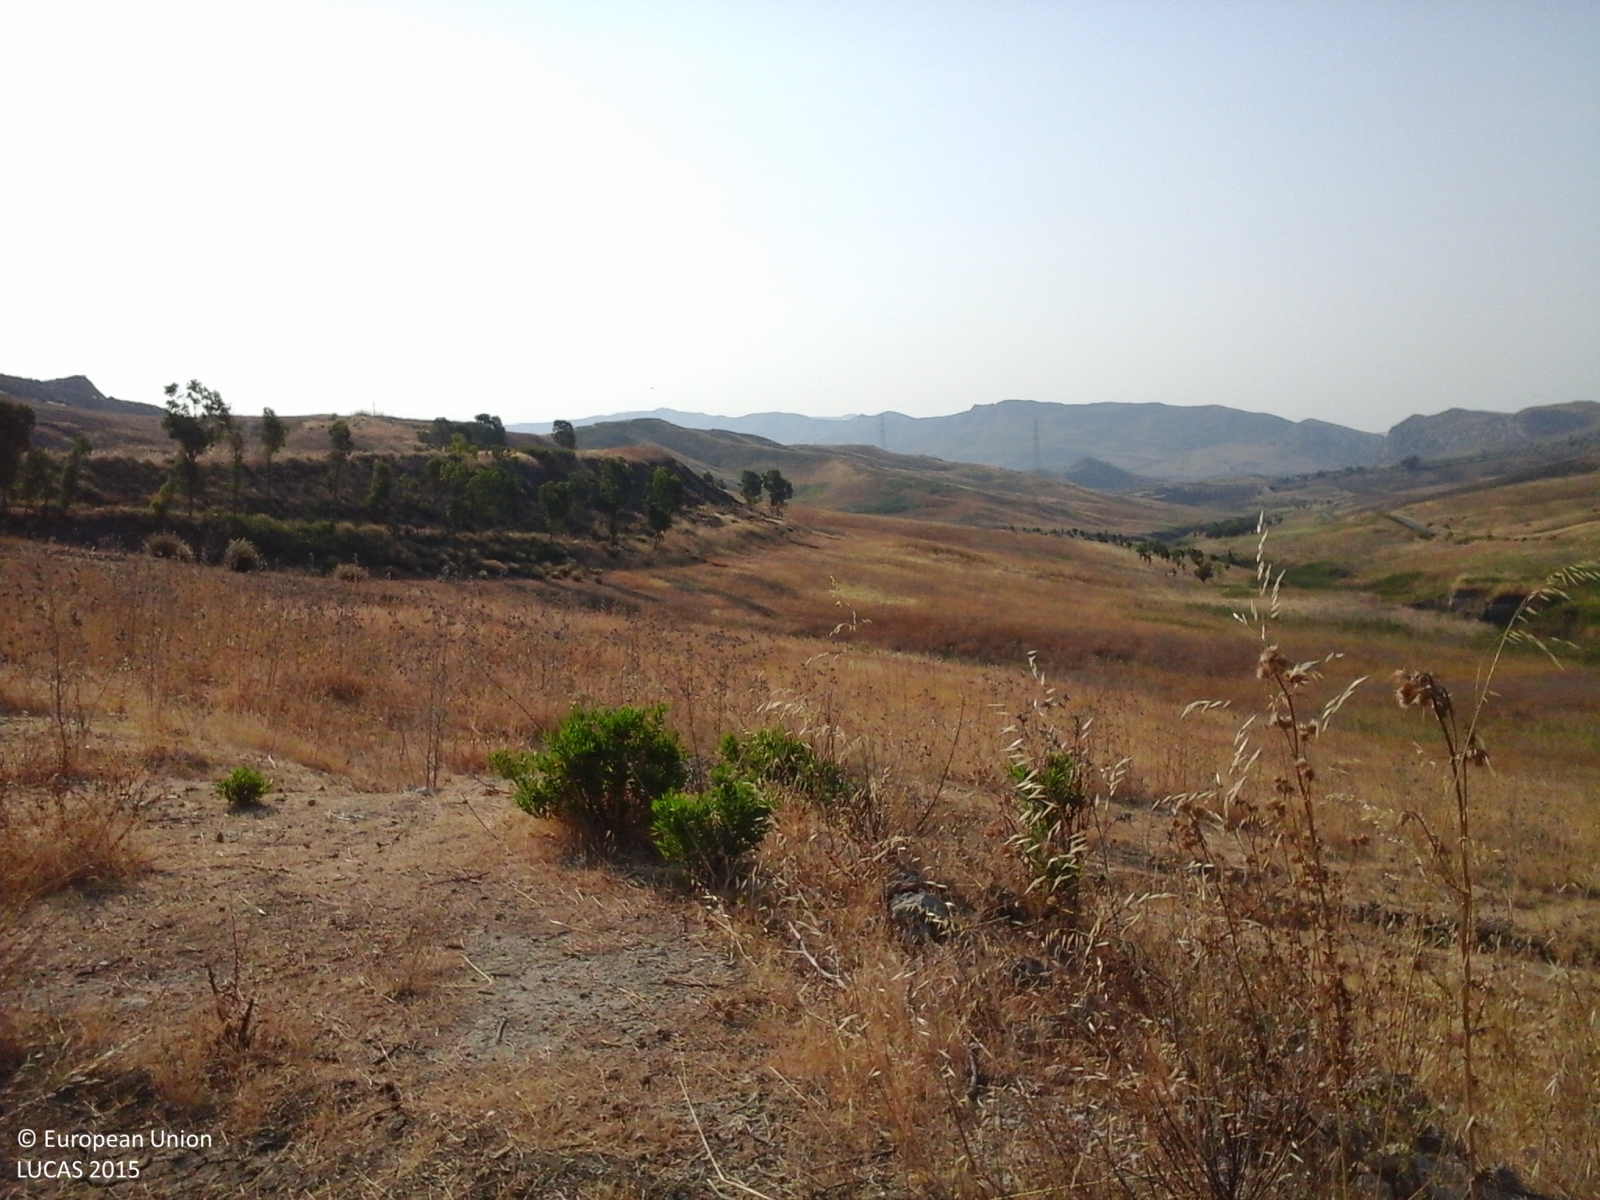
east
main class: Grassland
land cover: Grassland without tree/shrub cover
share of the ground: > 75 %
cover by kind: herbaceous plants 100 %
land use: Abandoned areas
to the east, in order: Grassland without tree/shrub cover
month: July
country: IT
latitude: 37.1767
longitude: 13.9001
